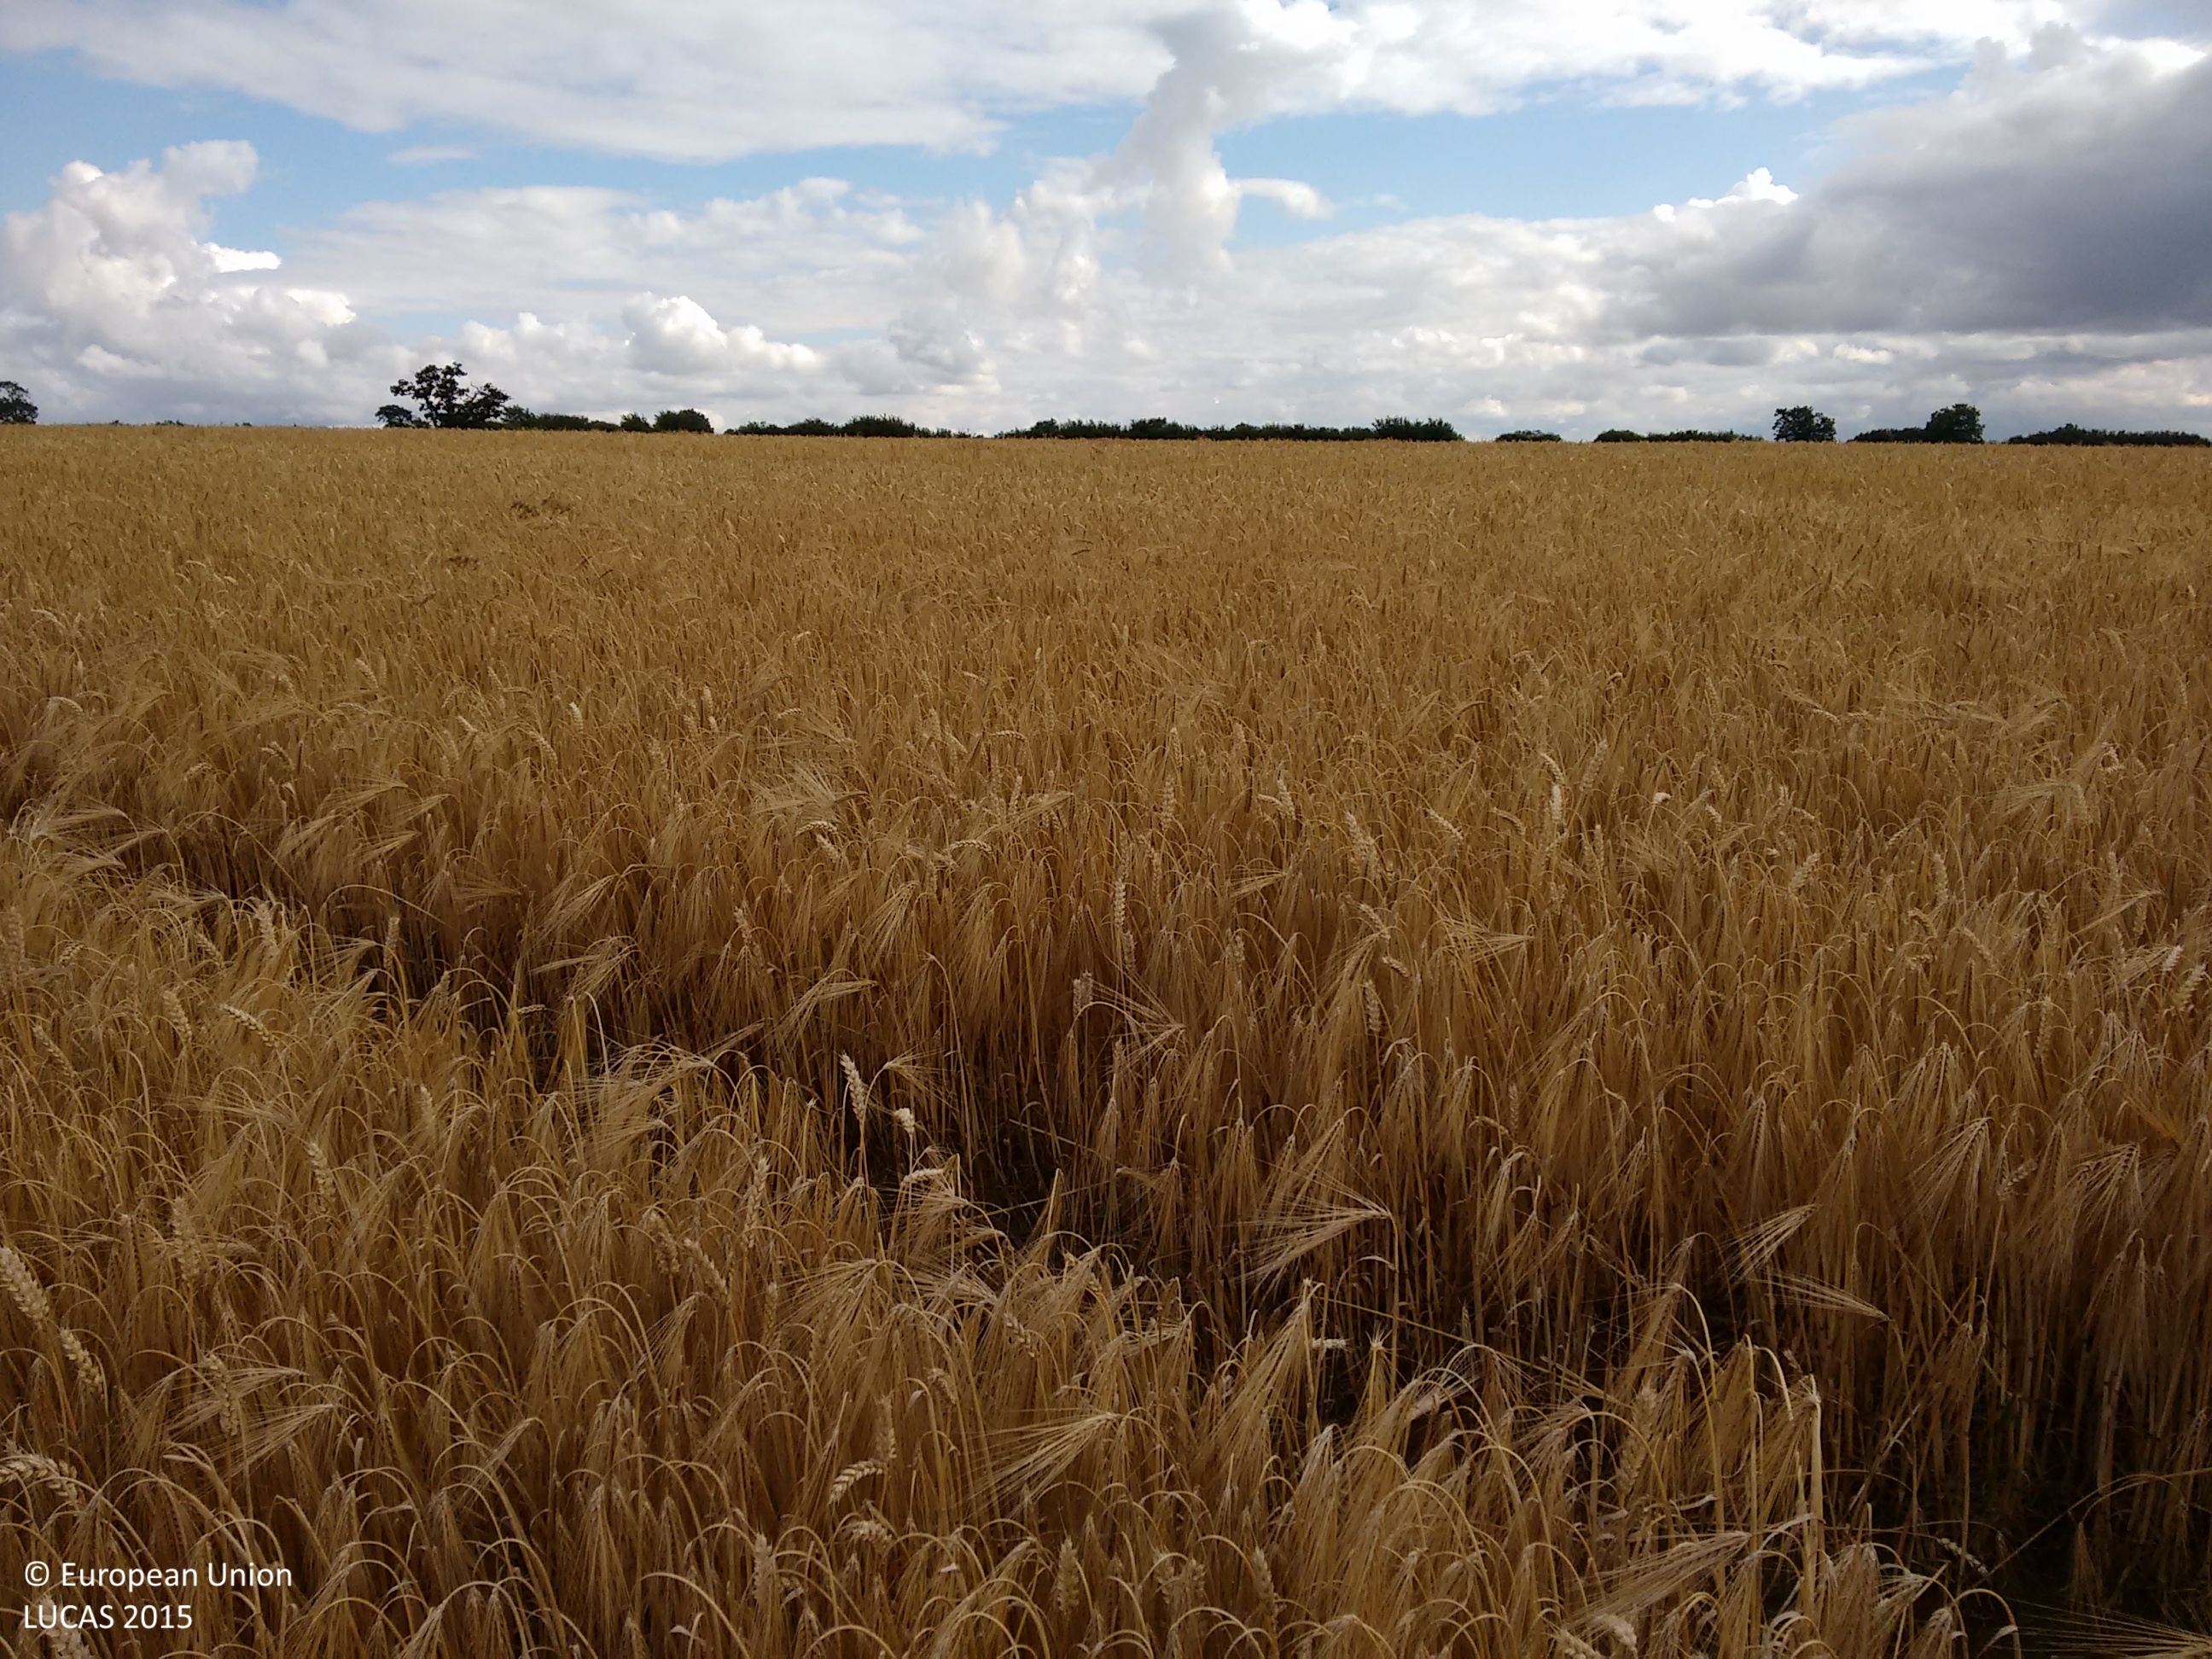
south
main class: Cropland
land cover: Mixed cereals for fodder
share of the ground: > 75 %
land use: Agriculture (excluding fallow land and kitchen gardens)
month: July
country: GB
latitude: 52.7964
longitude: -0.7337
